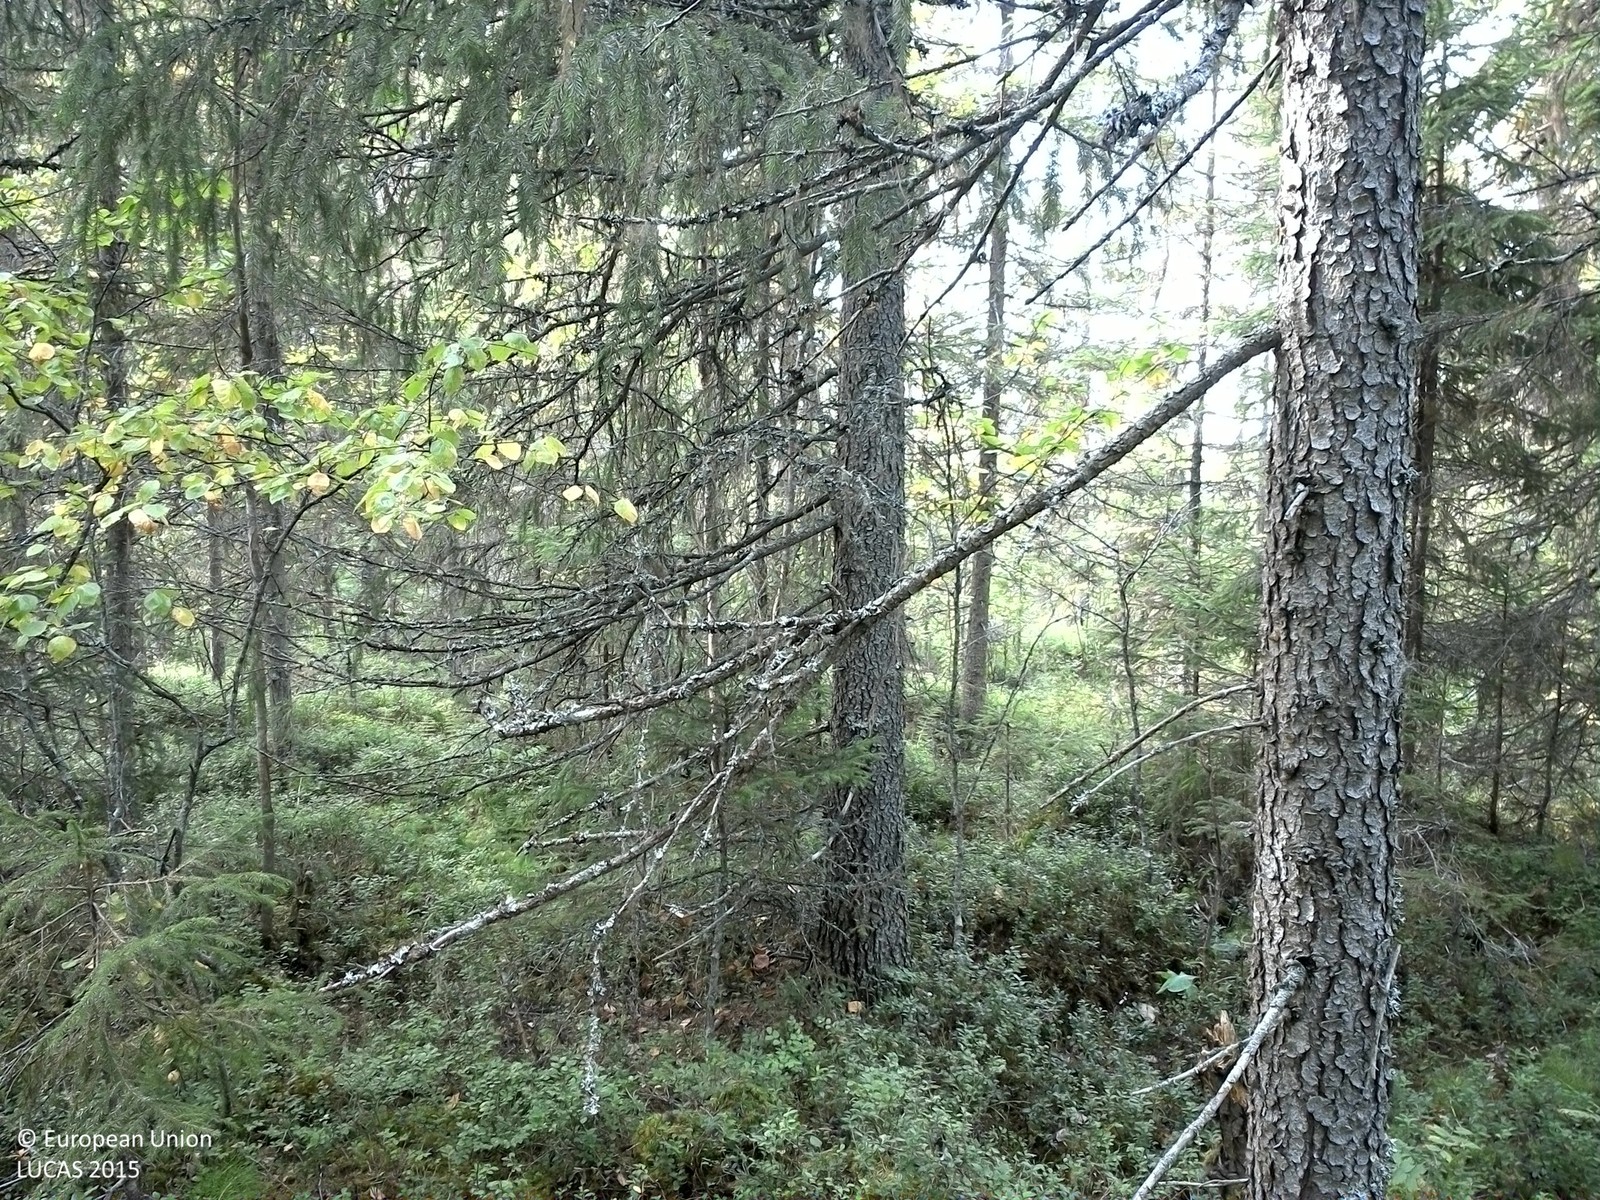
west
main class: Woodland
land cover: Spruce dominated coniferous woodland
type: boreal forest
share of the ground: > 75 %
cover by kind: coniferous forest trees 55 %, shrubs 25 %, broadleaved forest trees 10 %, lichens and mosses 10 %
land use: Forestry
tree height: > 5 m
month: September
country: SE
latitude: 64.0277
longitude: 16.5403
